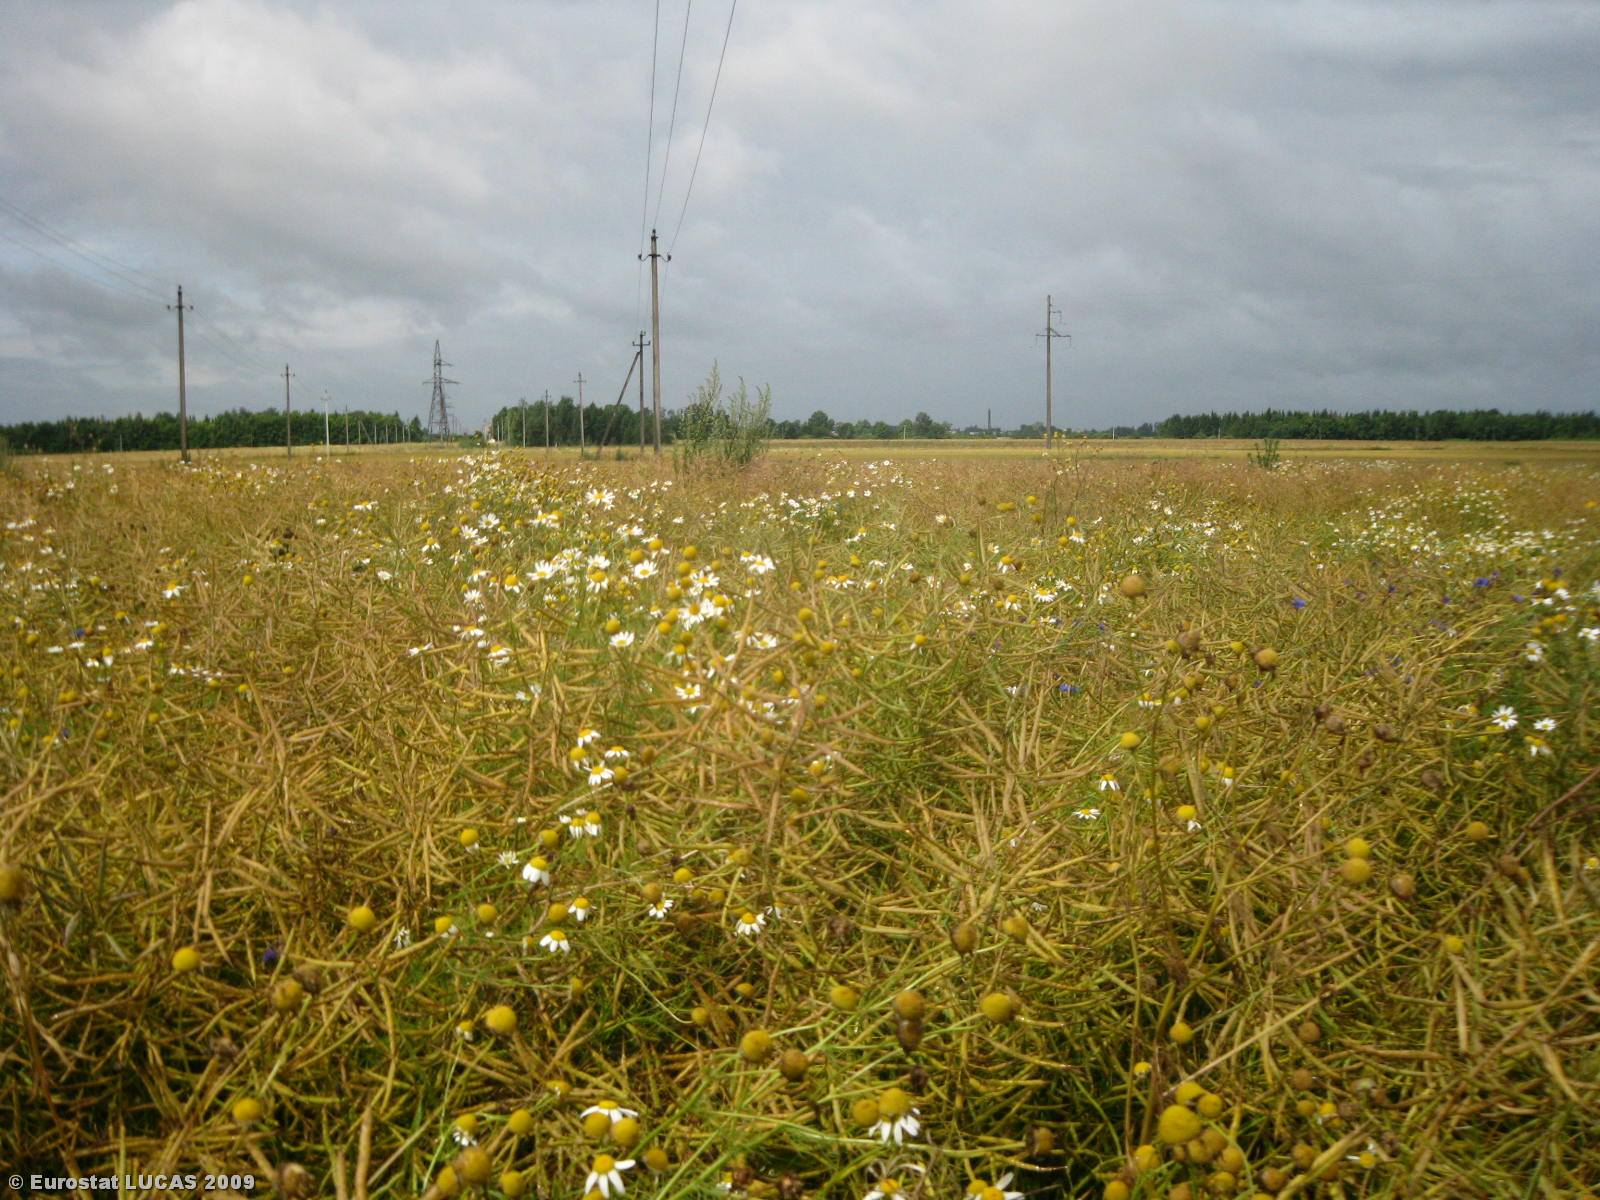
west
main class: Cropland
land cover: Rape and turnip rape
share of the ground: > 75 %
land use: Agriculture (excluding fallow land and kitchen gardens)
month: July
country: LT
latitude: 55.5088
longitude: 23.8135
